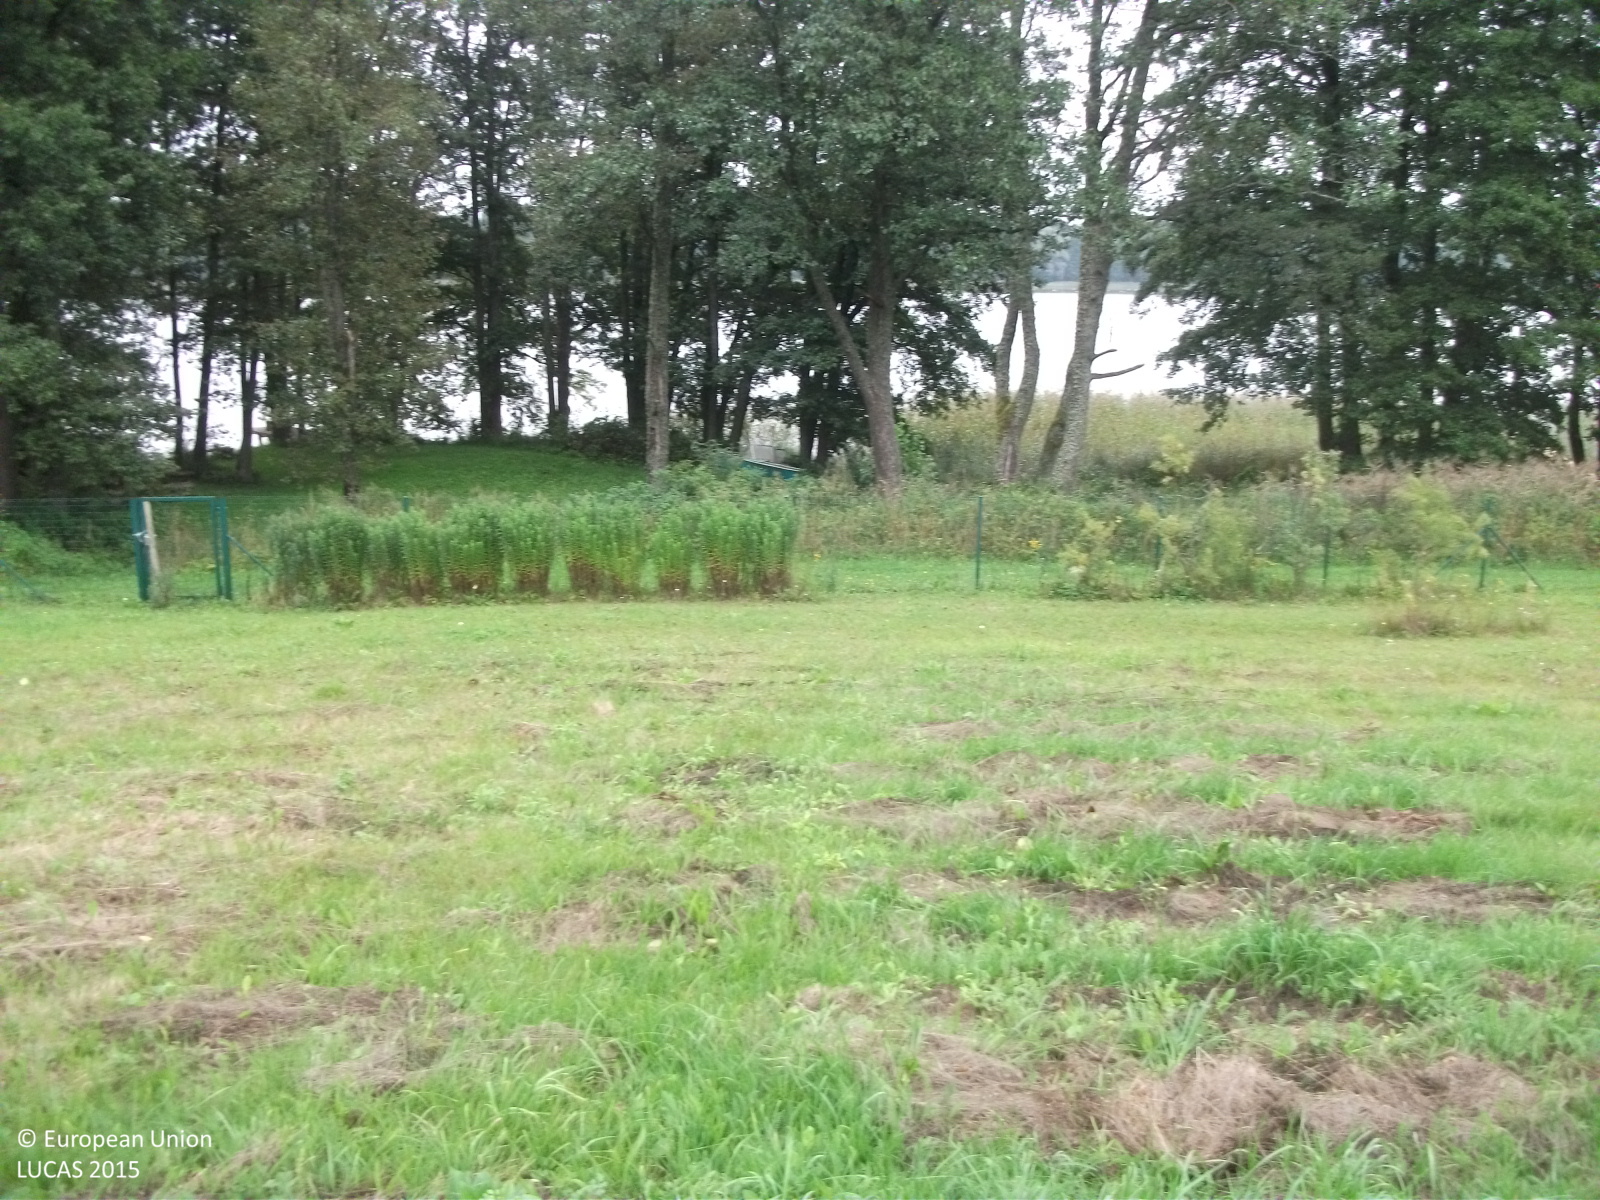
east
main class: Grassland
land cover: Grassland without tree/shrub cover
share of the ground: > 75 %
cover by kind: herbaceous plants 90 %, unconsolidated bare surface 5 %
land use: Residential
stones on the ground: < 10 %
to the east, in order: Grassland without tree/shrub cover; Fences; Managed hedges; Grassland without tree/shrub cover; Broadleaved woodland; Inland fresh water bodies
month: September
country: LV
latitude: 57.4969
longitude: 24.6956
